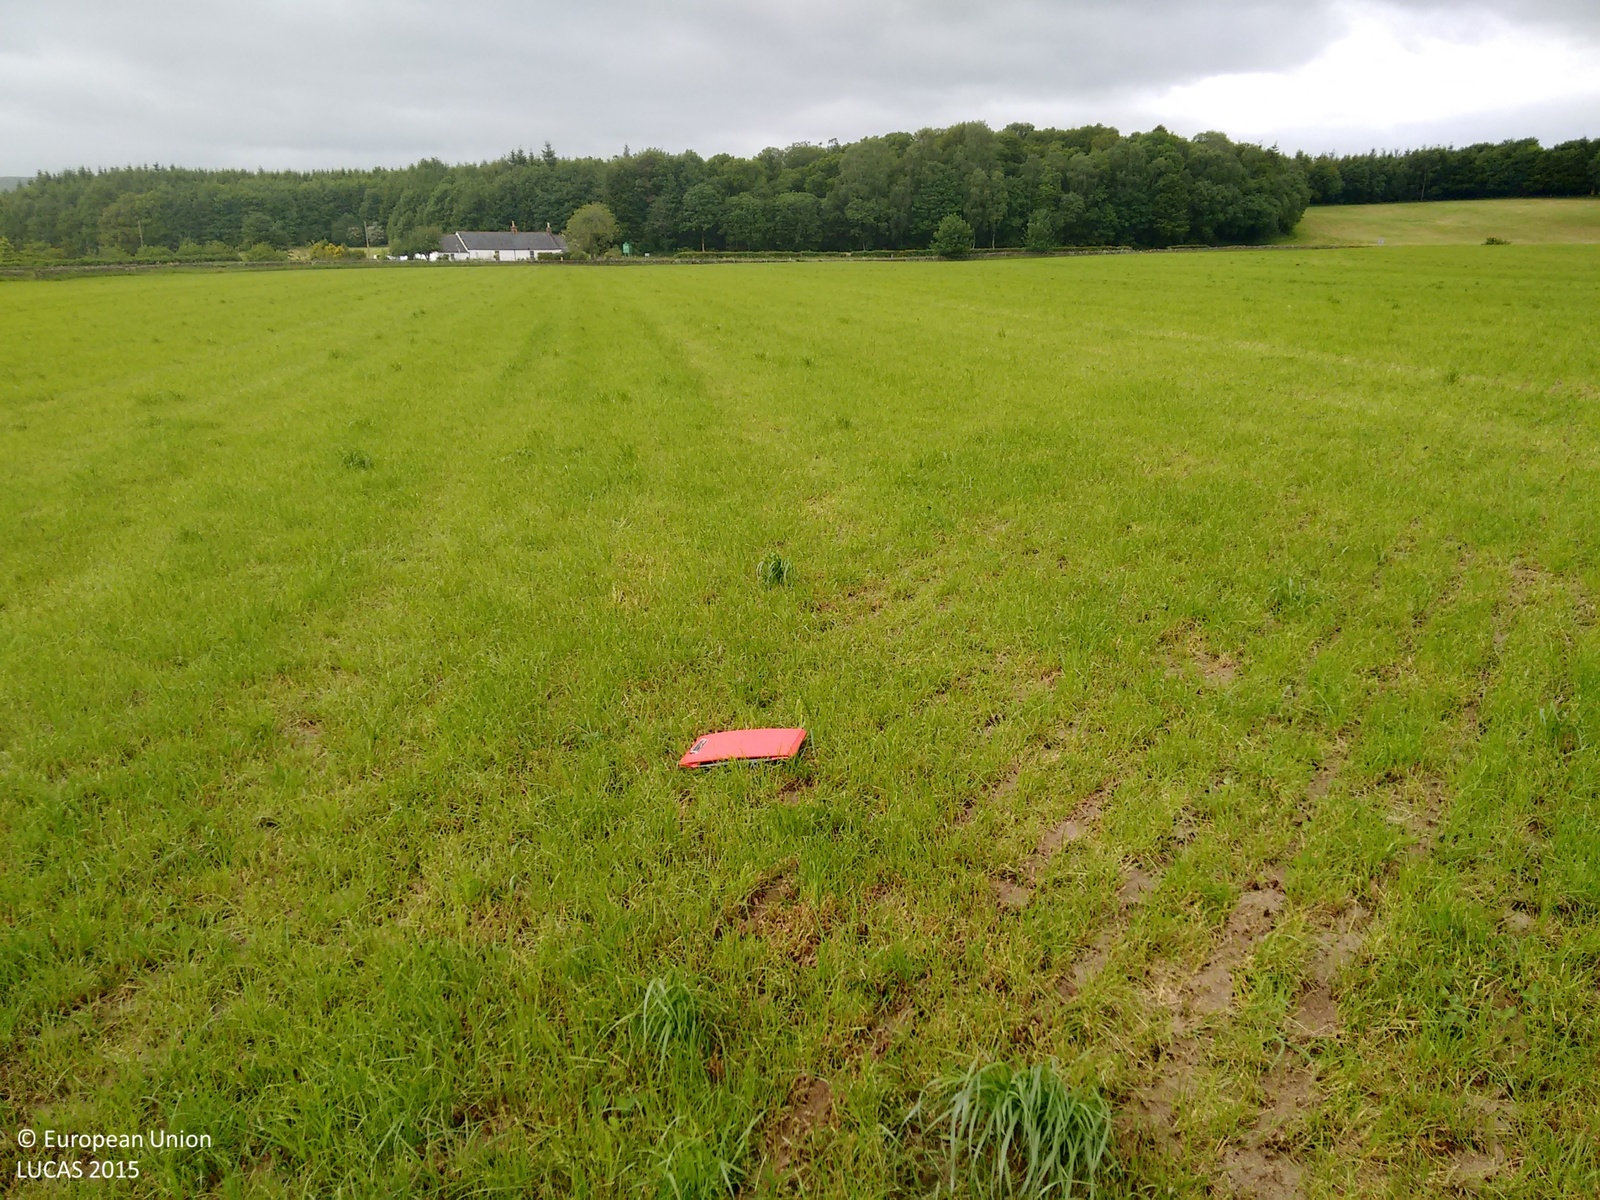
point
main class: Grassland
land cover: Grassland without tree/shrub cover
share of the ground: 50 - 75 %
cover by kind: herbaceous plants 90 %, unconsolidated bare surface 10 %
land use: Agriculture (excluding fallow land and kitchen gardens)
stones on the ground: < 10 %
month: June
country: GB
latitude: 55.2239
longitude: -3.7462
